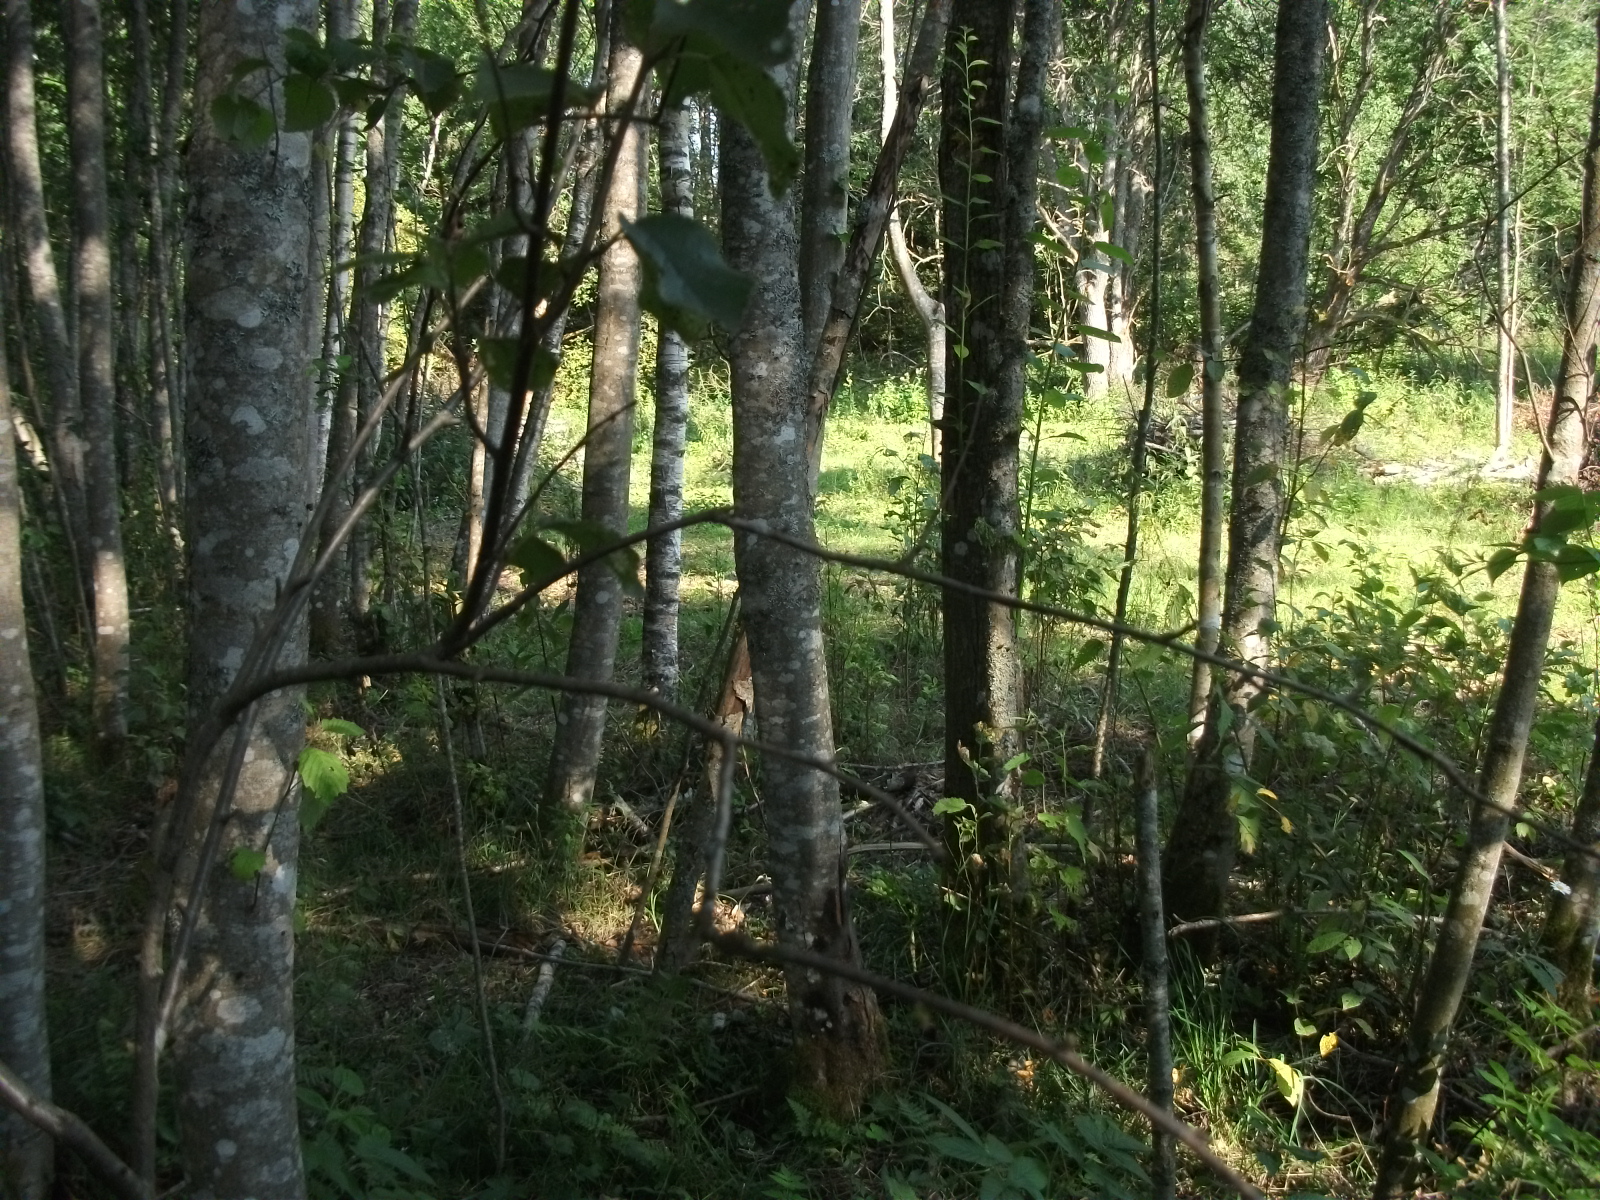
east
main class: Woodland
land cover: Broadleaved woodland
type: non-riverine alder, birch or aspen forest
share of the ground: > 75 %
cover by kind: broadleaved forest trees 85 %, herbaceous plants 10 %, shrubs 5 %
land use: Agriculture (excluding fallow land and kitchen gardens)
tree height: > 5 m
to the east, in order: Broadleaved woodland; Spruce dominated mixed woodland; Inland marshes; Broadleaved woodland; Inland marshes
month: August
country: LV
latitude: 56.8061
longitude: 25.7326
